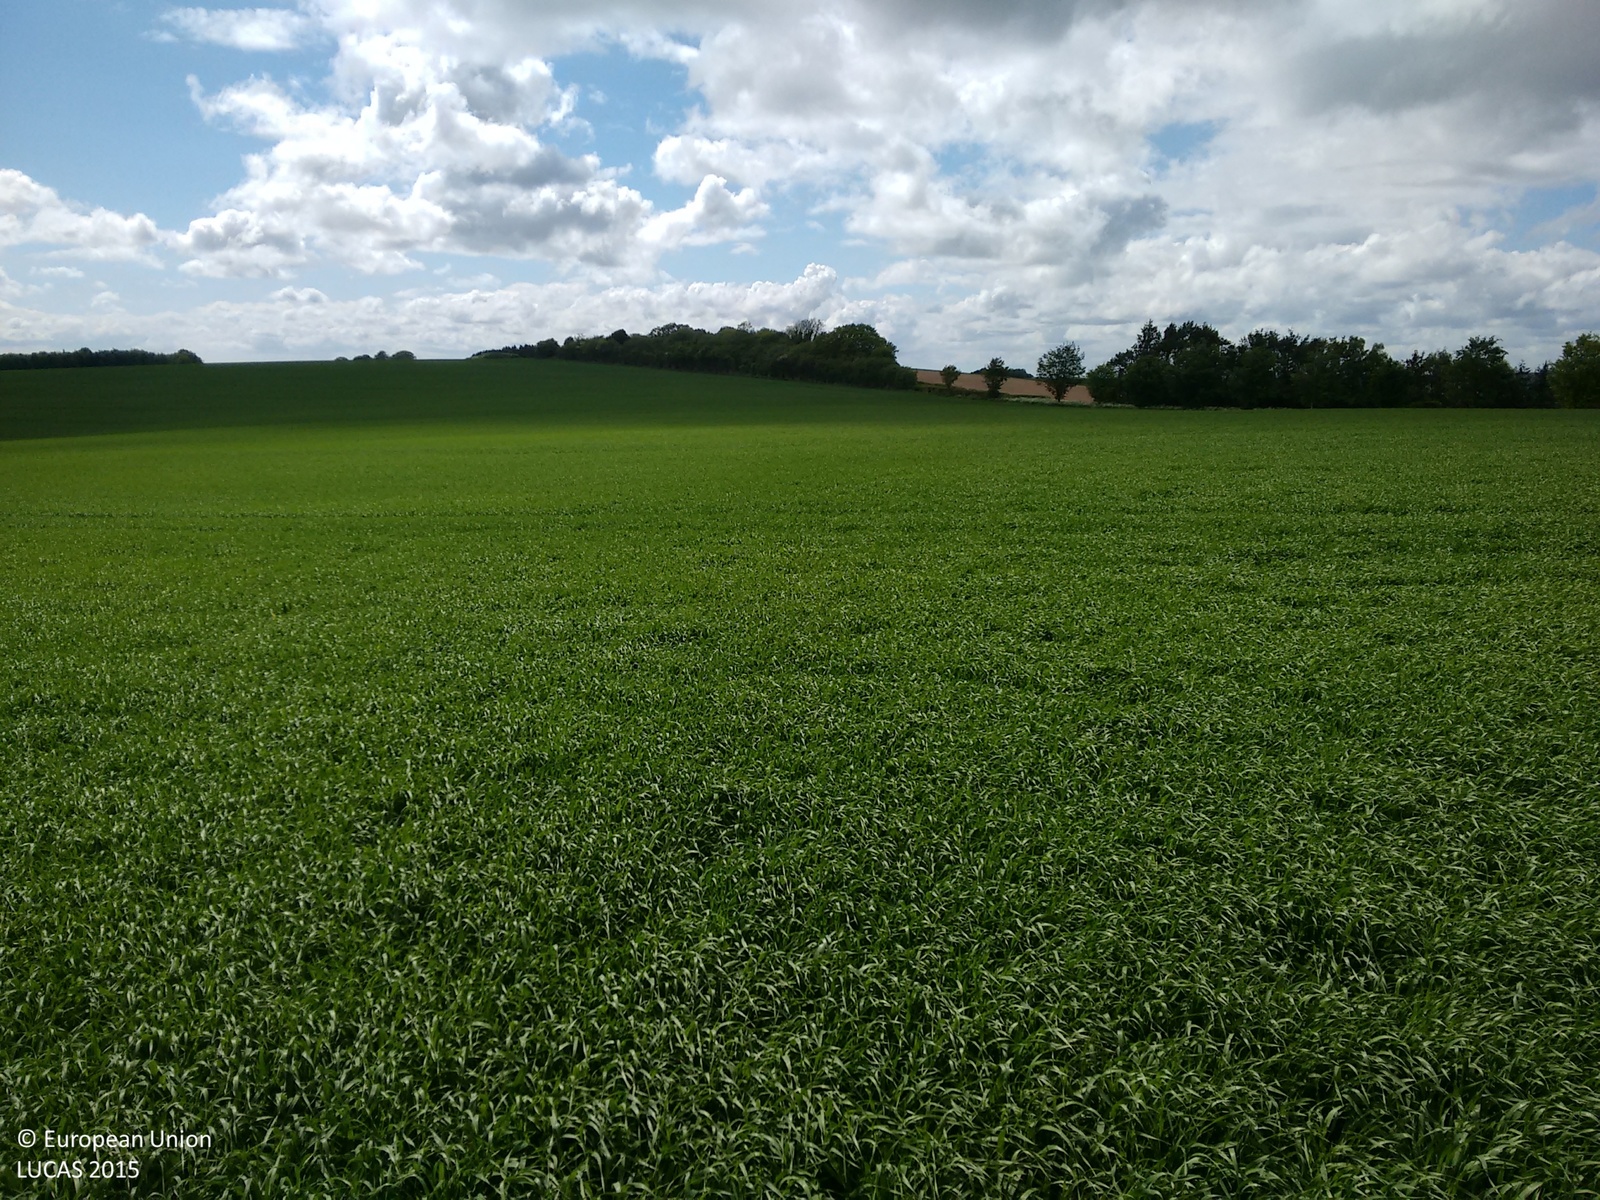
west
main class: Cropland
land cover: Barley
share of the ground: > 75 %
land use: Agriculture (excluding fallow land and kitchen gardens)
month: May
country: GB
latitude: 50.9674
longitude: -1.0812
